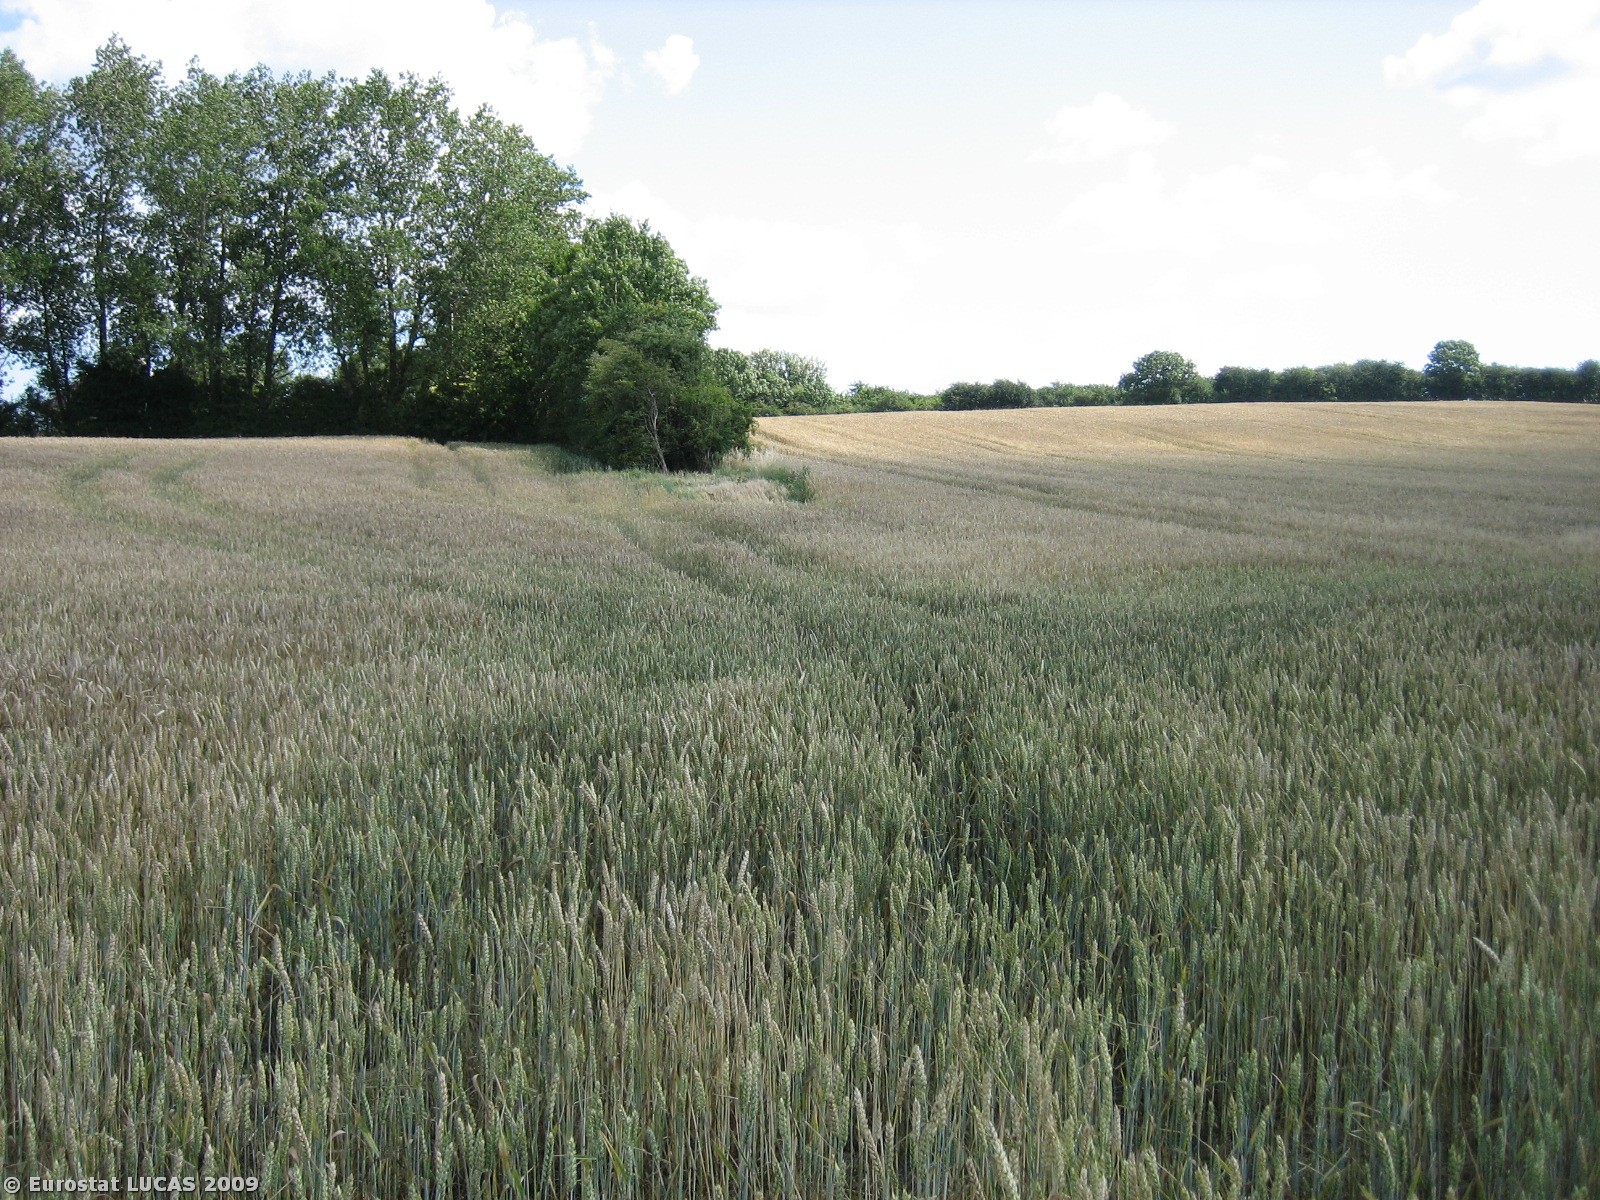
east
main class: Cropland
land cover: Common wheat
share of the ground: > 75 %
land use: Agriculture (excluding fallow land and kitchen gardens)
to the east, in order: Common wheat; Broadleaved woodland; Grass margins; Tracks; Grassland without tree/shrub cover; Broadleaved woodland; Arable land (only in case pi); Broadleaved woodland; Grassland without tree/shrub cover; Spontaneously vegetated surfaces
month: July
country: DK
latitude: 55.5046
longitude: 9.8893
